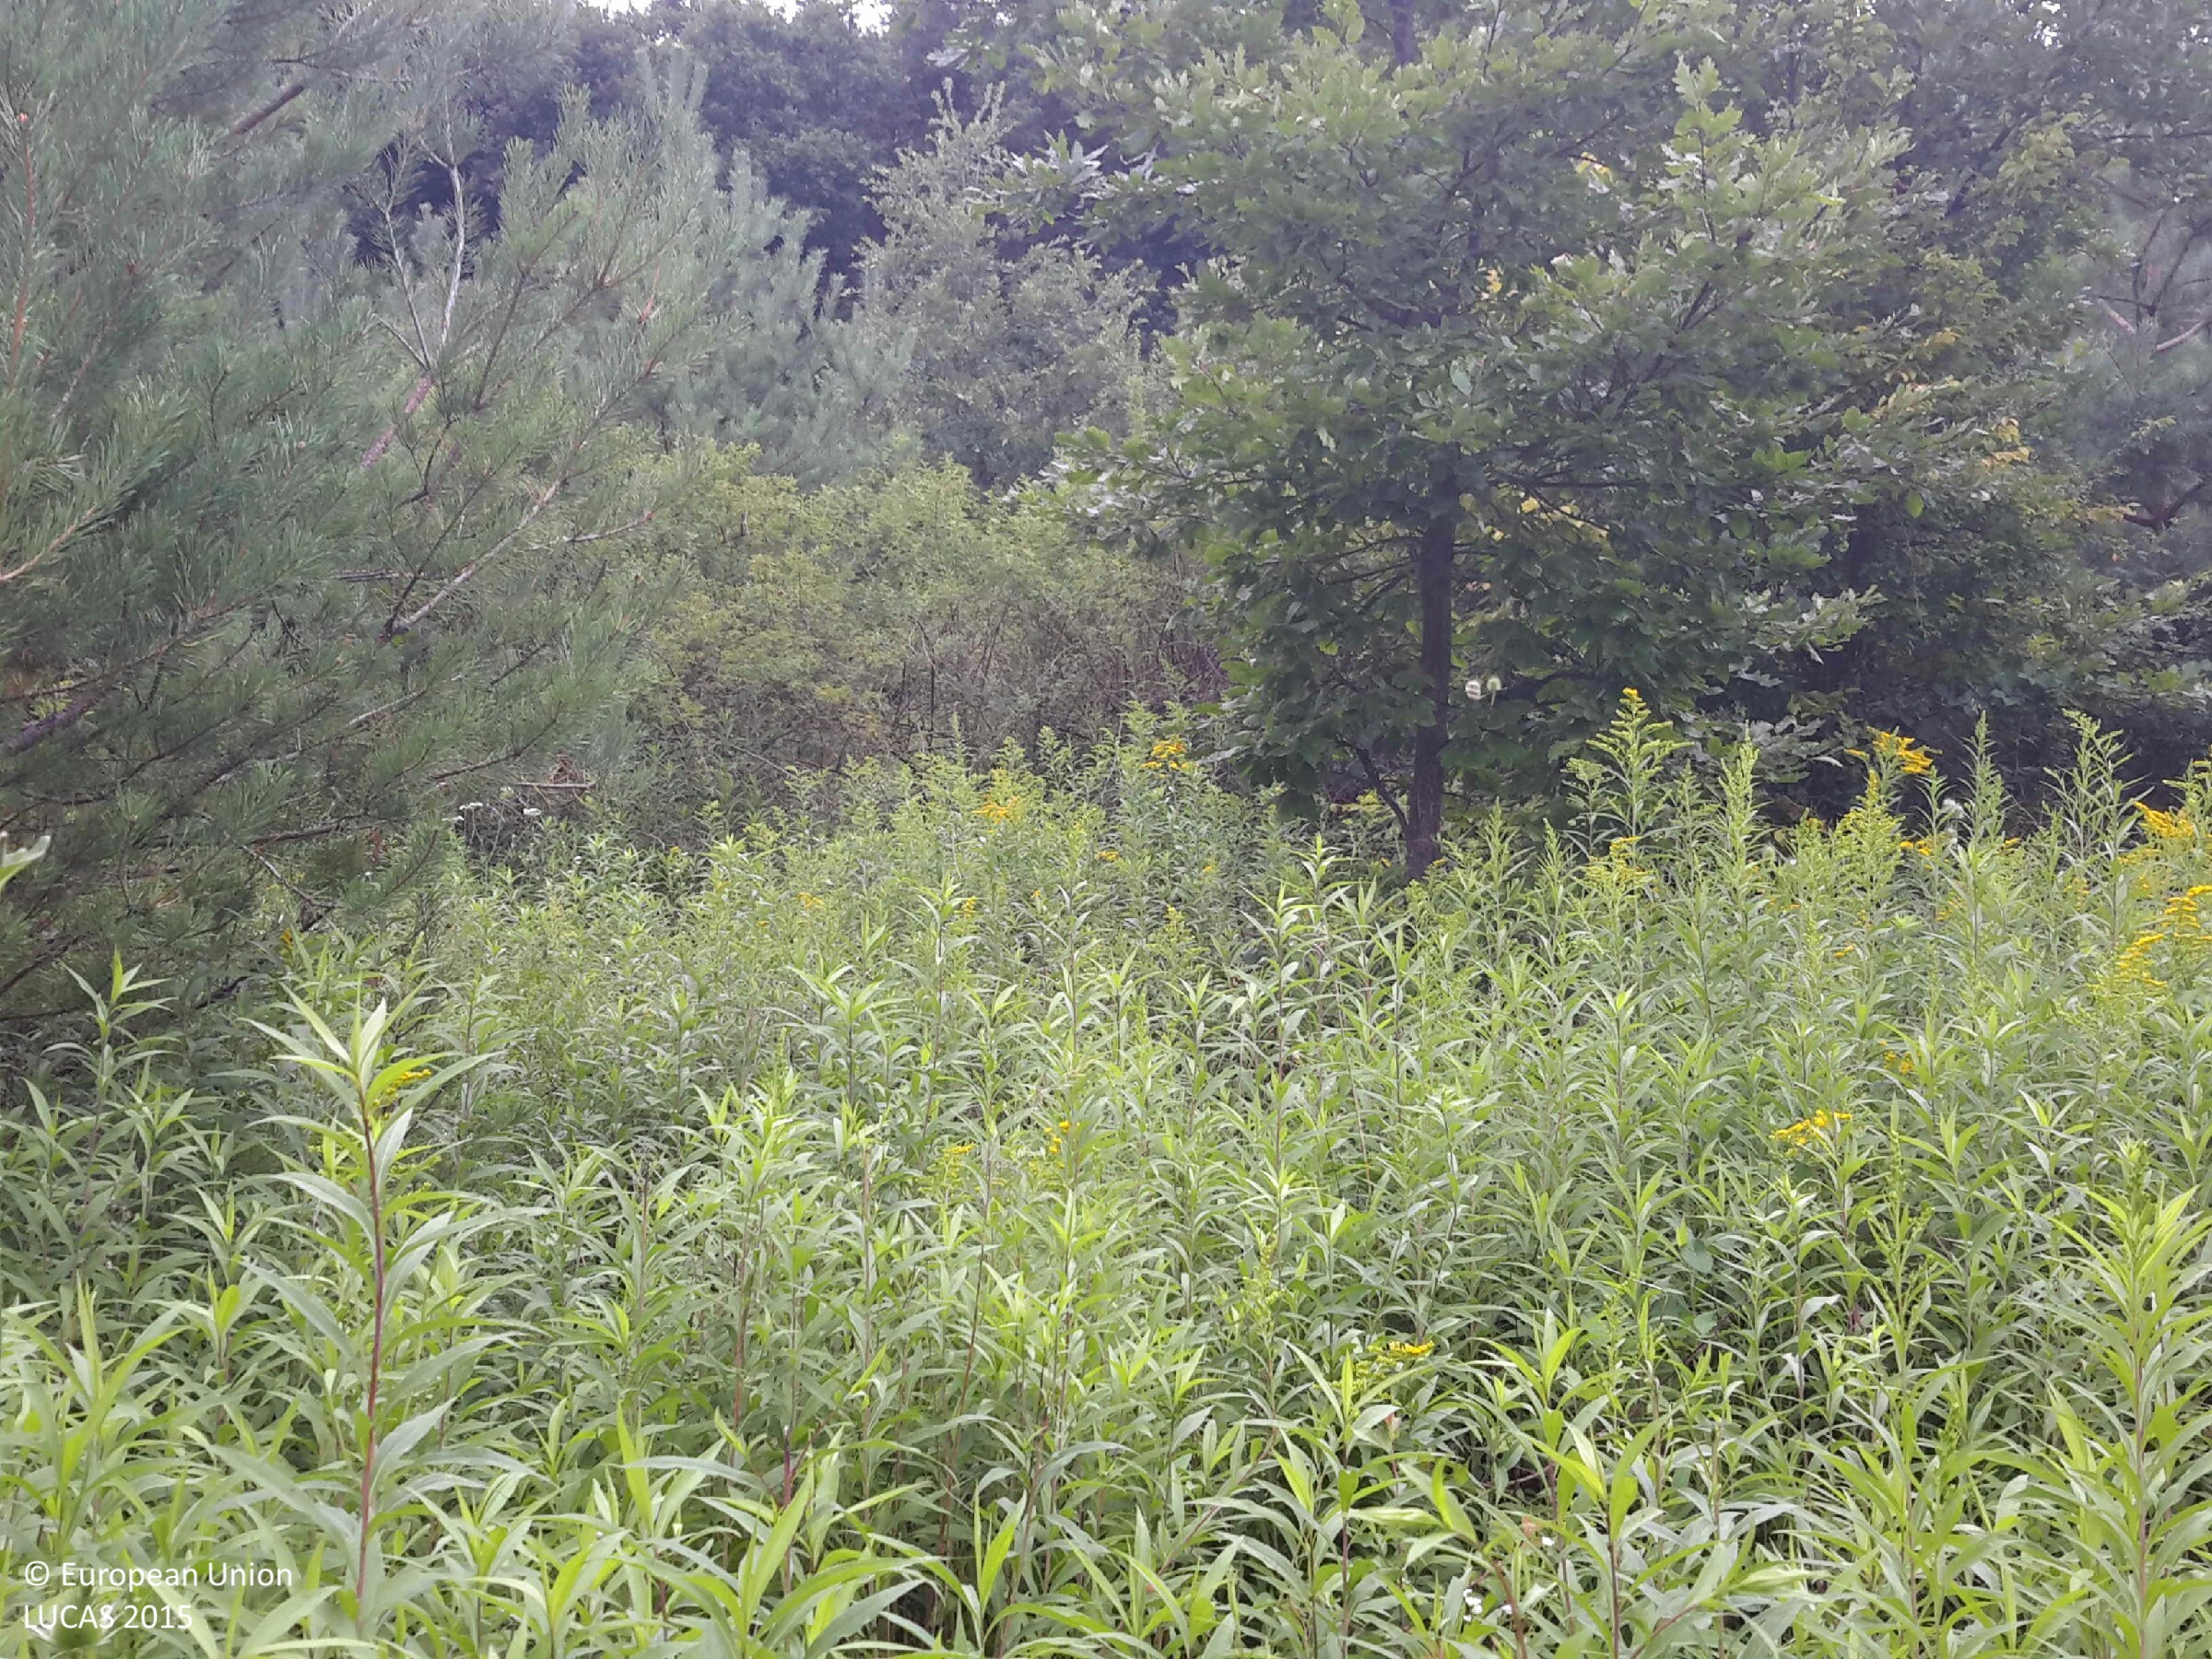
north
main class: Woodland
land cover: Pine dominated coniferous woodland
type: hemiboreal forest and nemoral coniferous forest and mixed broadleaved-coniferous forest
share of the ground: 25 - 50 %
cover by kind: coniferous forest trees 50 %, herbaceous plants 40 %, broadleaved forest trees 10 %
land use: Forestry
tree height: > 5 m
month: July
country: HU
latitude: 47.2020
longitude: 16.4846
